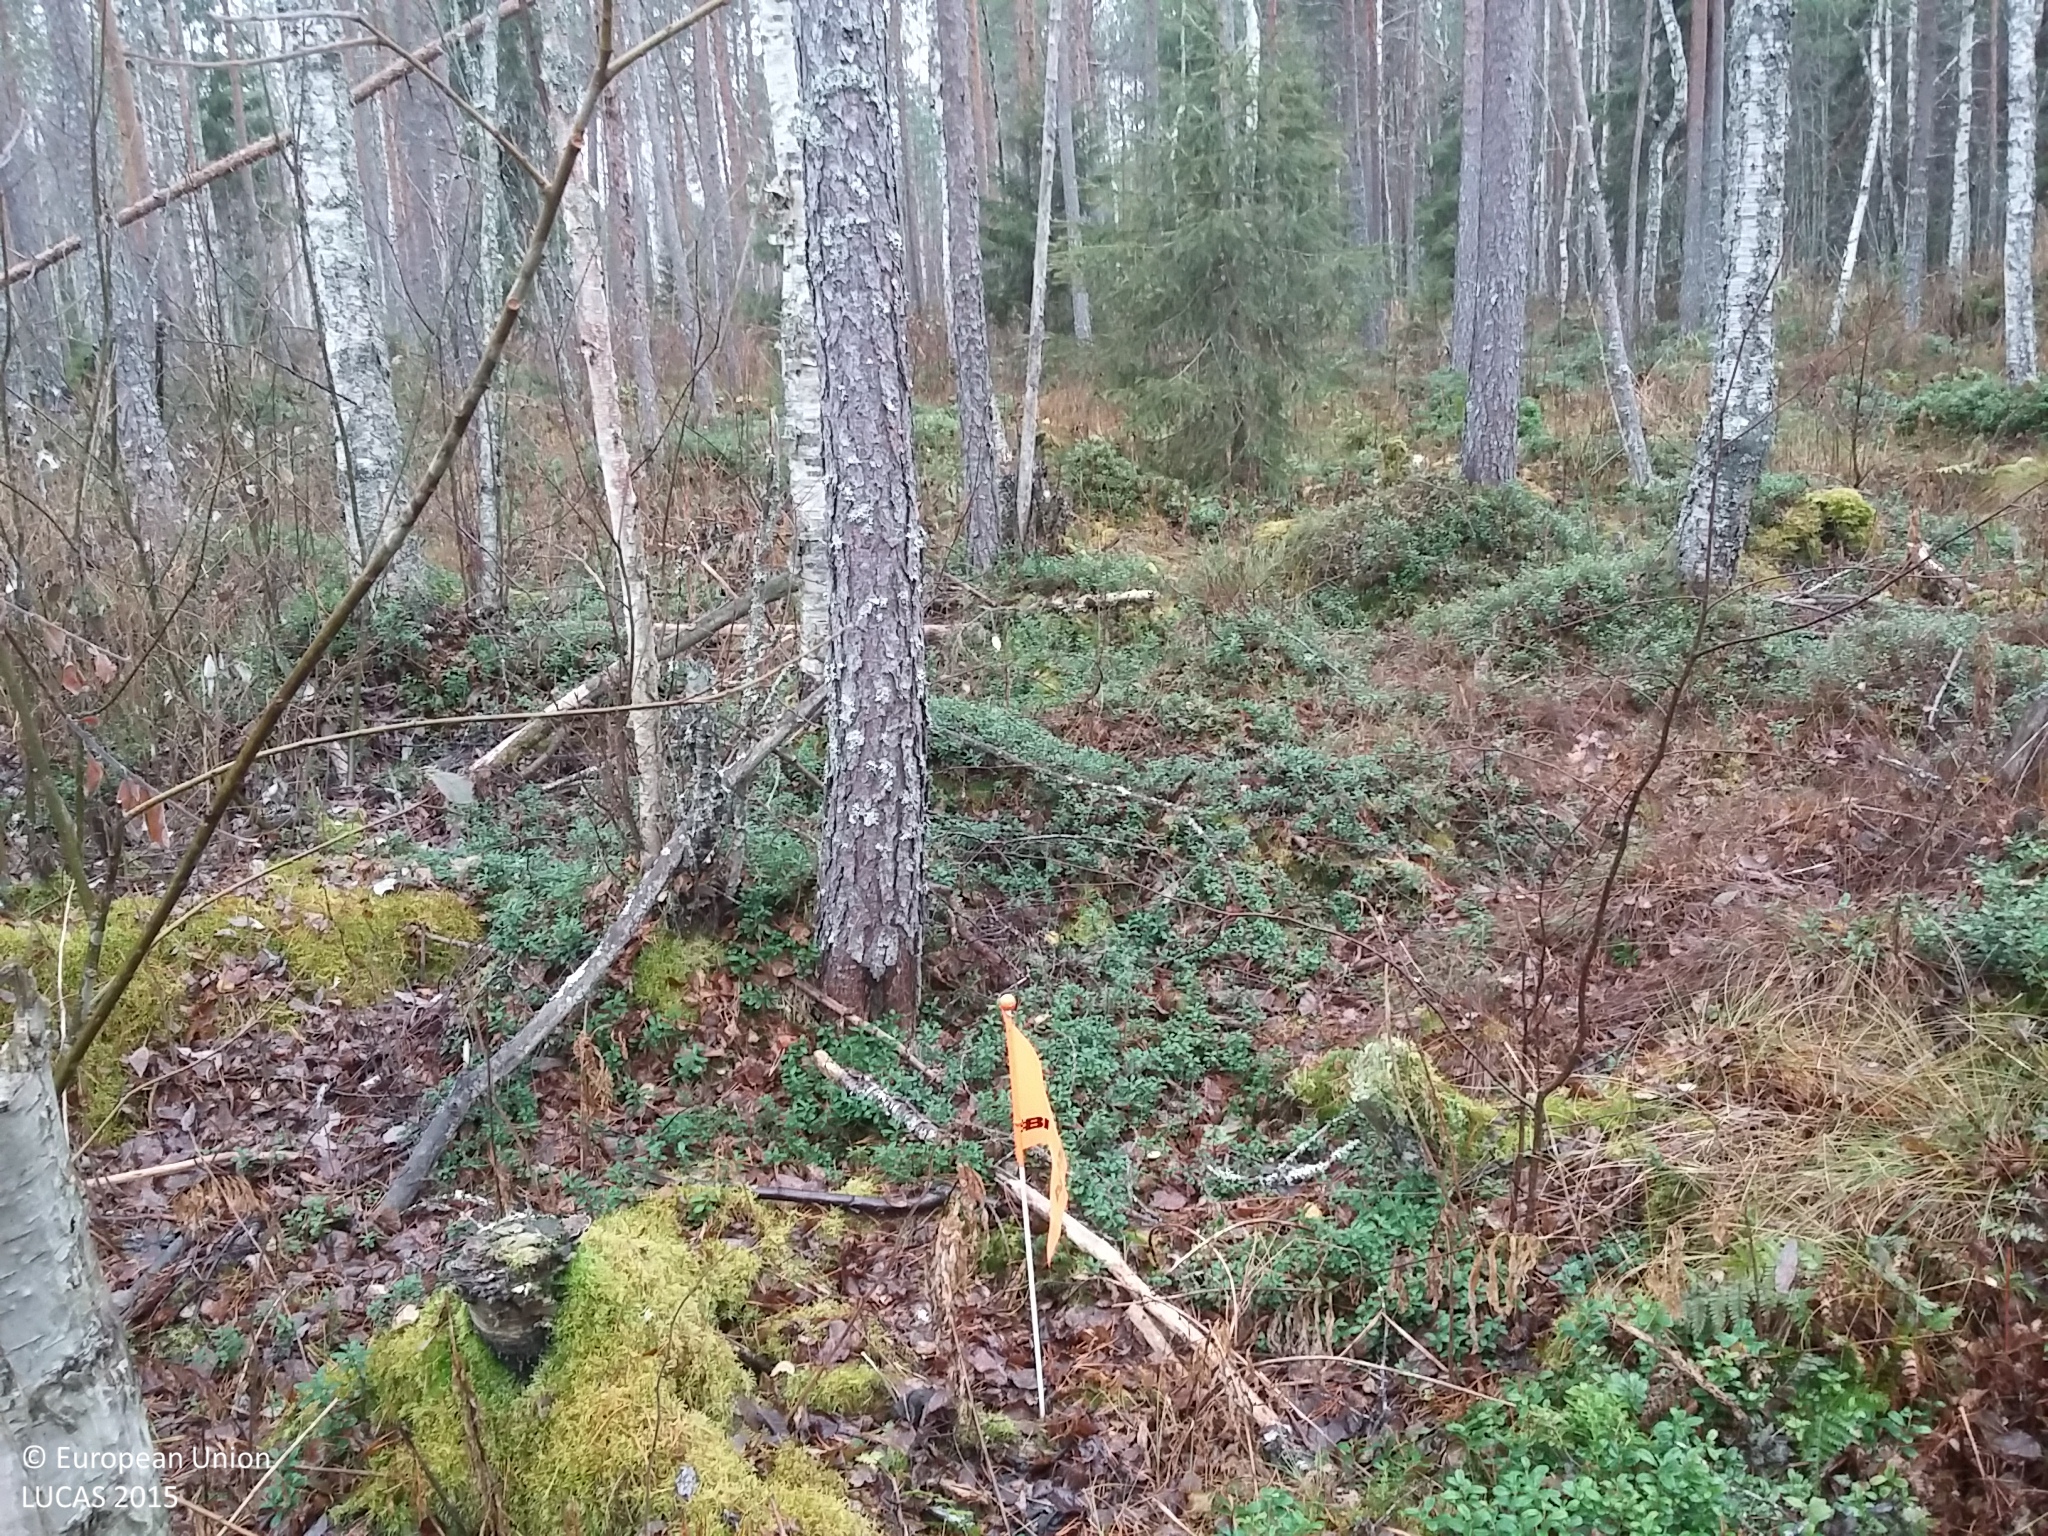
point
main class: Woodland
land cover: Pine dominated coniferous woodland
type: boreal forest
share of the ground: > 75 %
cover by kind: coniferous forest trees 65 %, broadleaved forest trees 10 %, shrubs 10 %, herbaceous plants 10 %, lichens and mosses 5 %
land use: Forestry
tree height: > 5 m
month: October
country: FI
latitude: 64.5266
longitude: 25.4039
